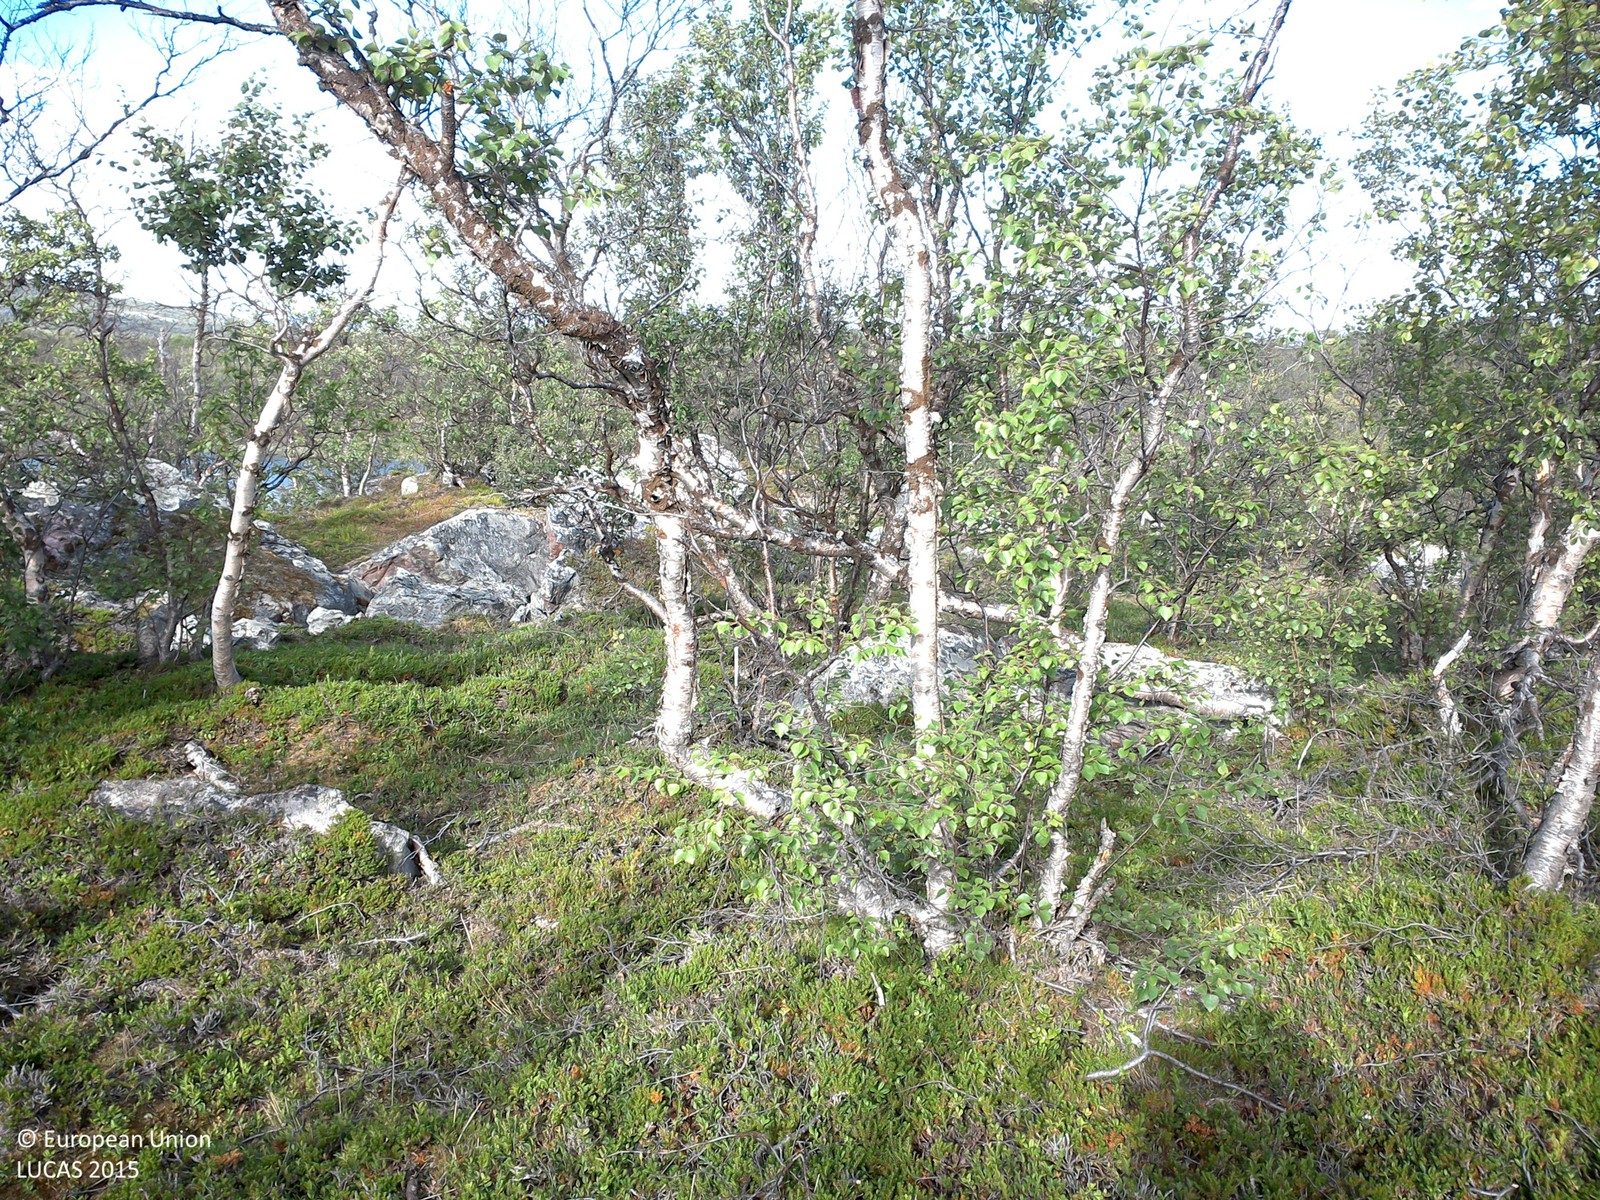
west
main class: Woodland
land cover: Broadleaved woodland
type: boreal forest
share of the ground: 10 - 25 %
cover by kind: shrubs 55 %, broadleaved forest trees 20 %, lichens and mosses 20 %, unconsolidated bare surface 5 %
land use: Amenities, museums, leisure
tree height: < 5 m
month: August
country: SE
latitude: 68.3500
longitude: 19.0885
